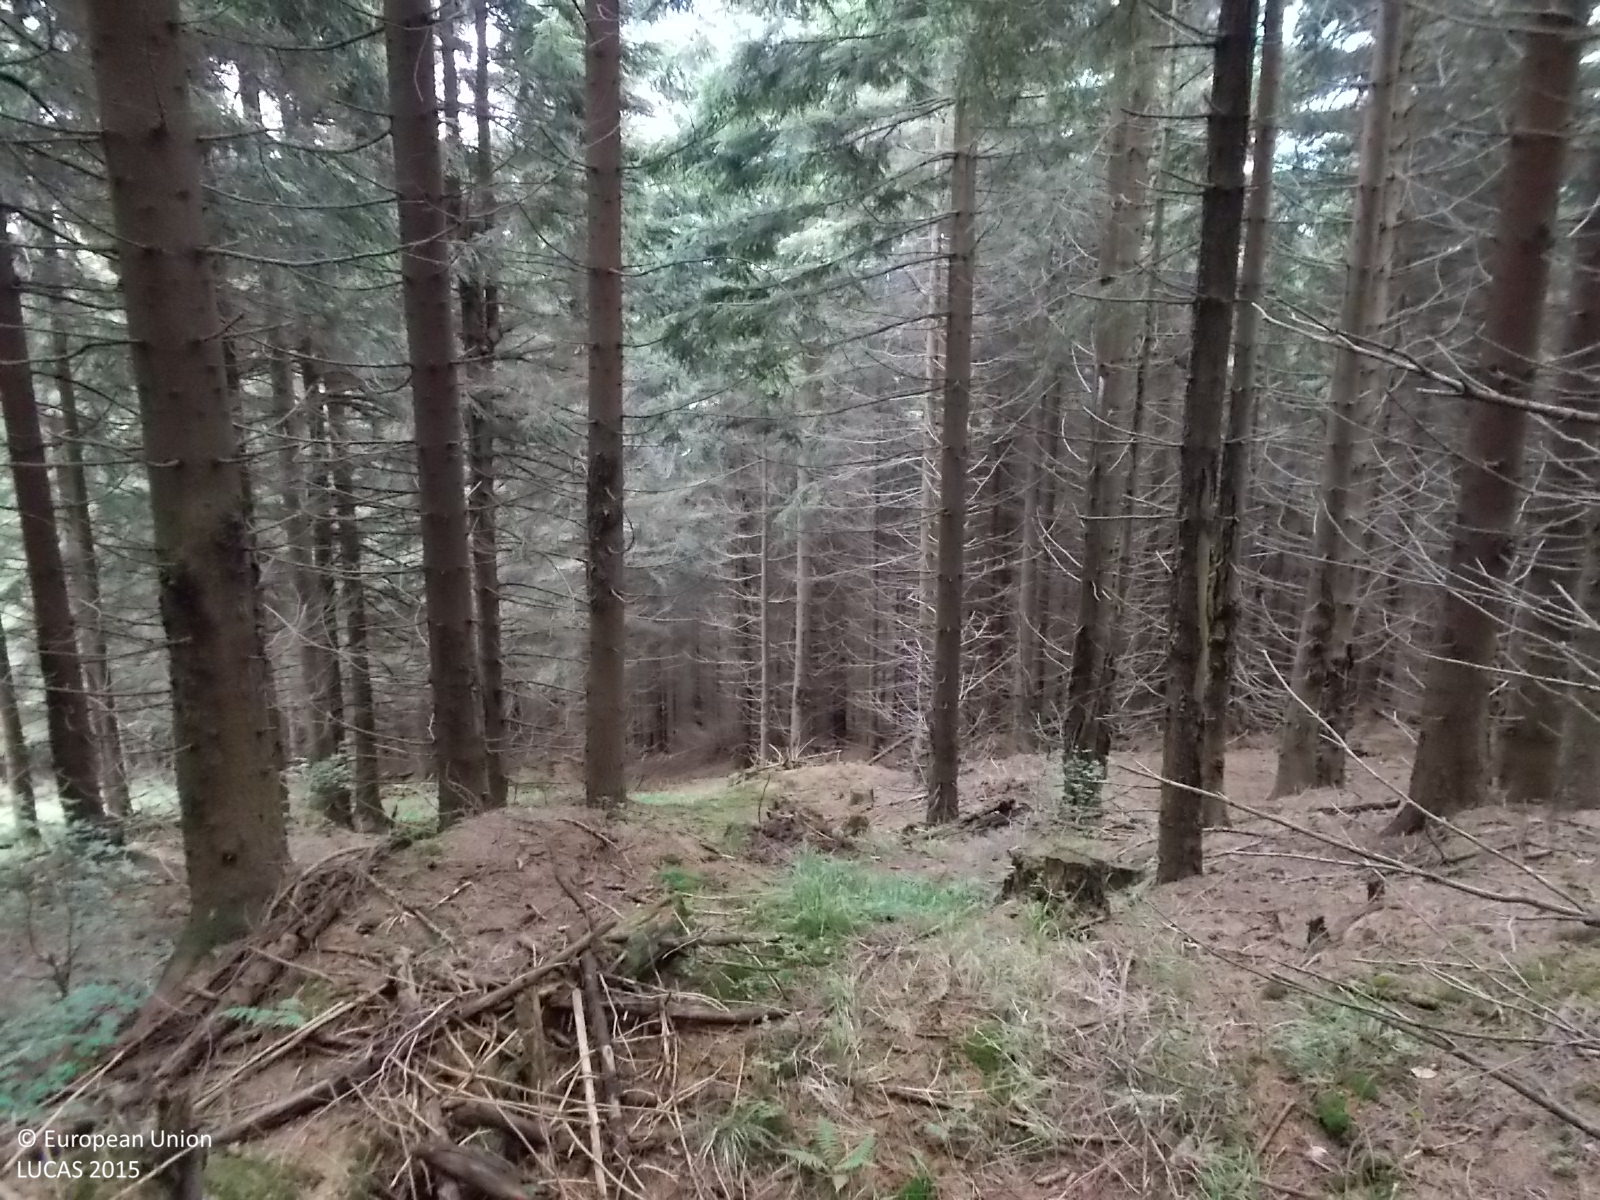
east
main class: Woodland
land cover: Spruce dominated coniferous woodland
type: hemiboreal forest and nemoral coniferous forest and mixed broadleaved-coniferous forest
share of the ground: > 75 %
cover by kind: coniferous forest trees 90 %, herbaceous plants 5 %, unconsolidated bare surface 5 %
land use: Forestry
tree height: > 5 m
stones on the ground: < 10 %
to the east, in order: Spruce dominated coniferous woodland; Ditches and canals; Spruce dominated coniferous woodland; Tracks; Spruce dominated mixed woodland
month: June
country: CZ
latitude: 50.1771
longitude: 17.1380
